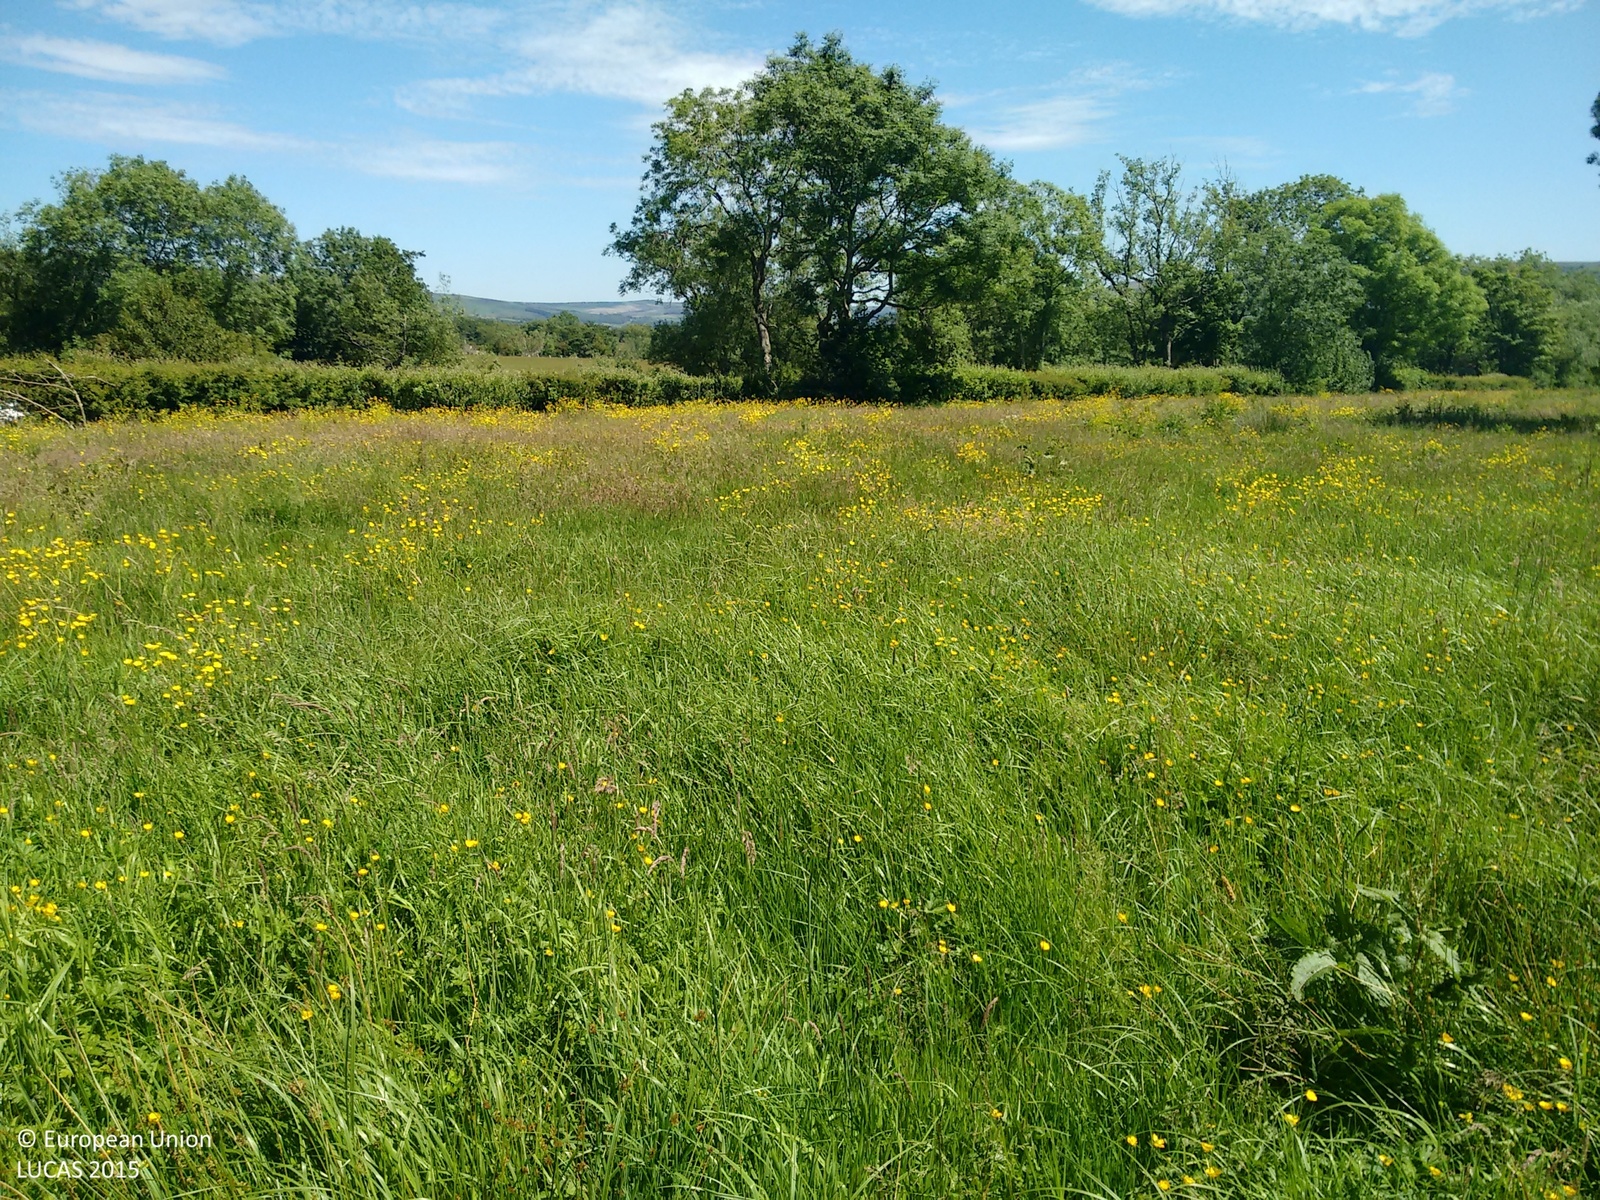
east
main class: Grassland
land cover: Grassland without tree/shrub cover
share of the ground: > 75 %
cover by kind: herbaceous plants 100 %
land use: Agriculture (excluding fallow land and kitchen gardens)
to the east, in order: Grassland without tree/shrub cover; Fences; Abandoned hedges; Grassland without tree/shrub cover; Abandoned hedges; Paved roads, cycling and walking lanes; Abandoned hedges; Grassland without tree/shrub cover; Broadleaved woodland; Rivers and streams; Broadleaved woodland; Grassland without tree/shrub cover; Fences
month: June
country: GB
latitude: 53.3510
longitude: -1.7872
